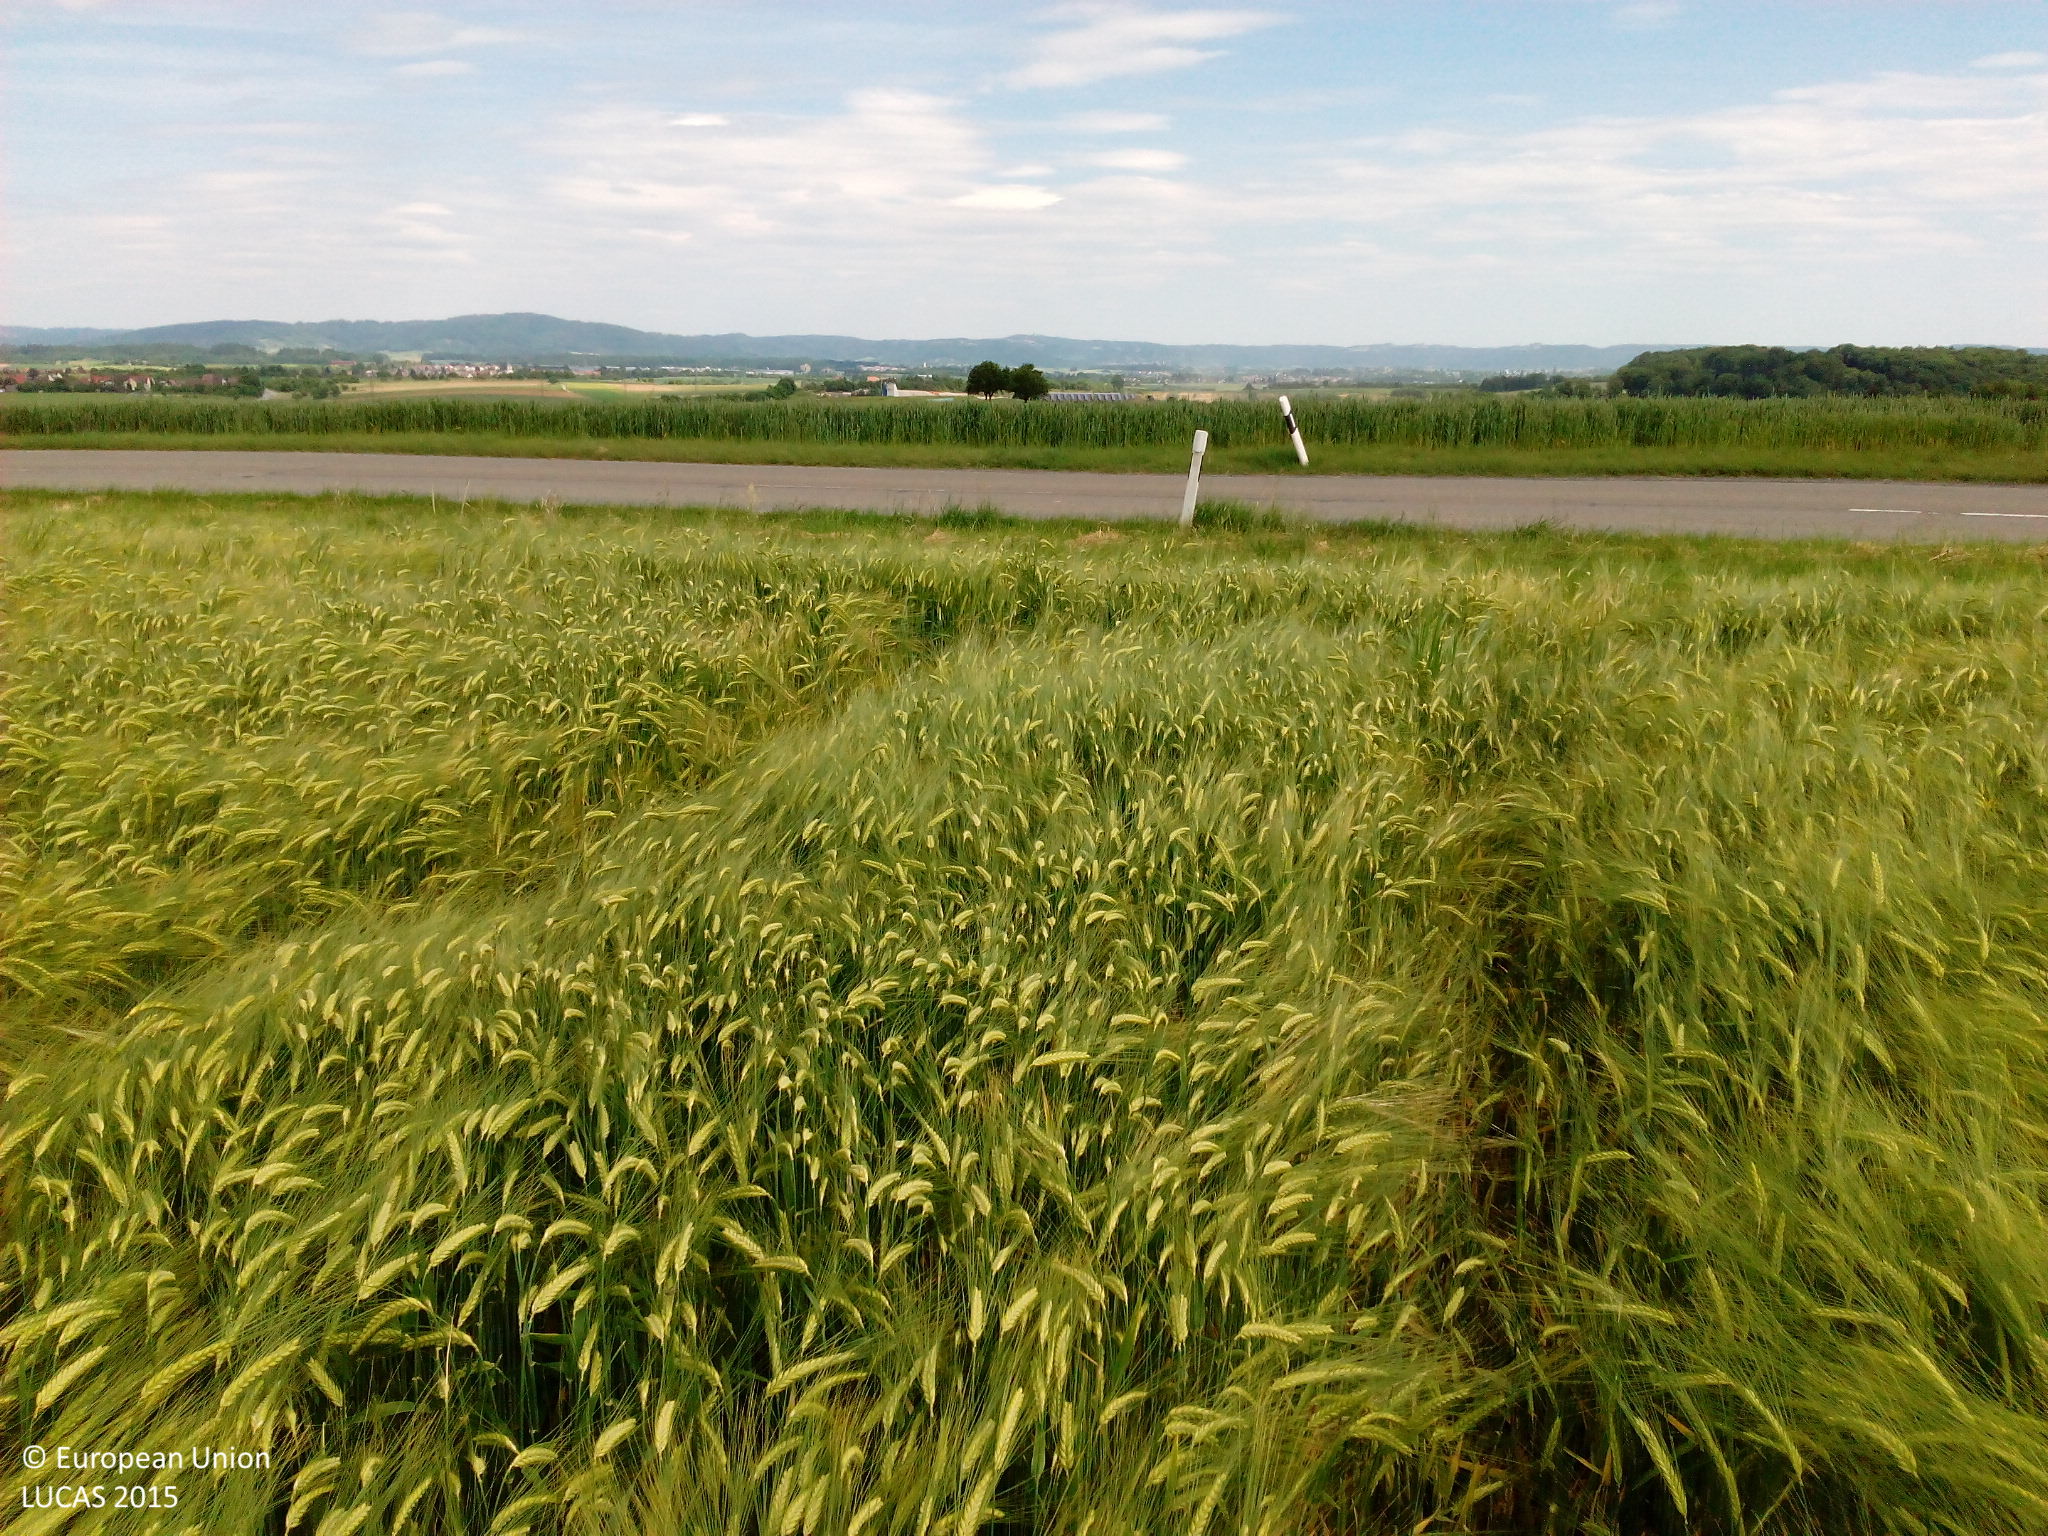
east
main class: Cropland
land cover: Rye
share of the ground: > 75 %
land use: Agriculture (excluding fallow land and kitchen gardens)
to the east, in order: Rye; Grassland without tree/shrub cover; Ditches and canals; Grass margins; Paved roads, cycling and walking lanes; Grass margins; Common wheat; Maize
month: June
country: DE
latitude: 48.9594
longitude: 9.3584
